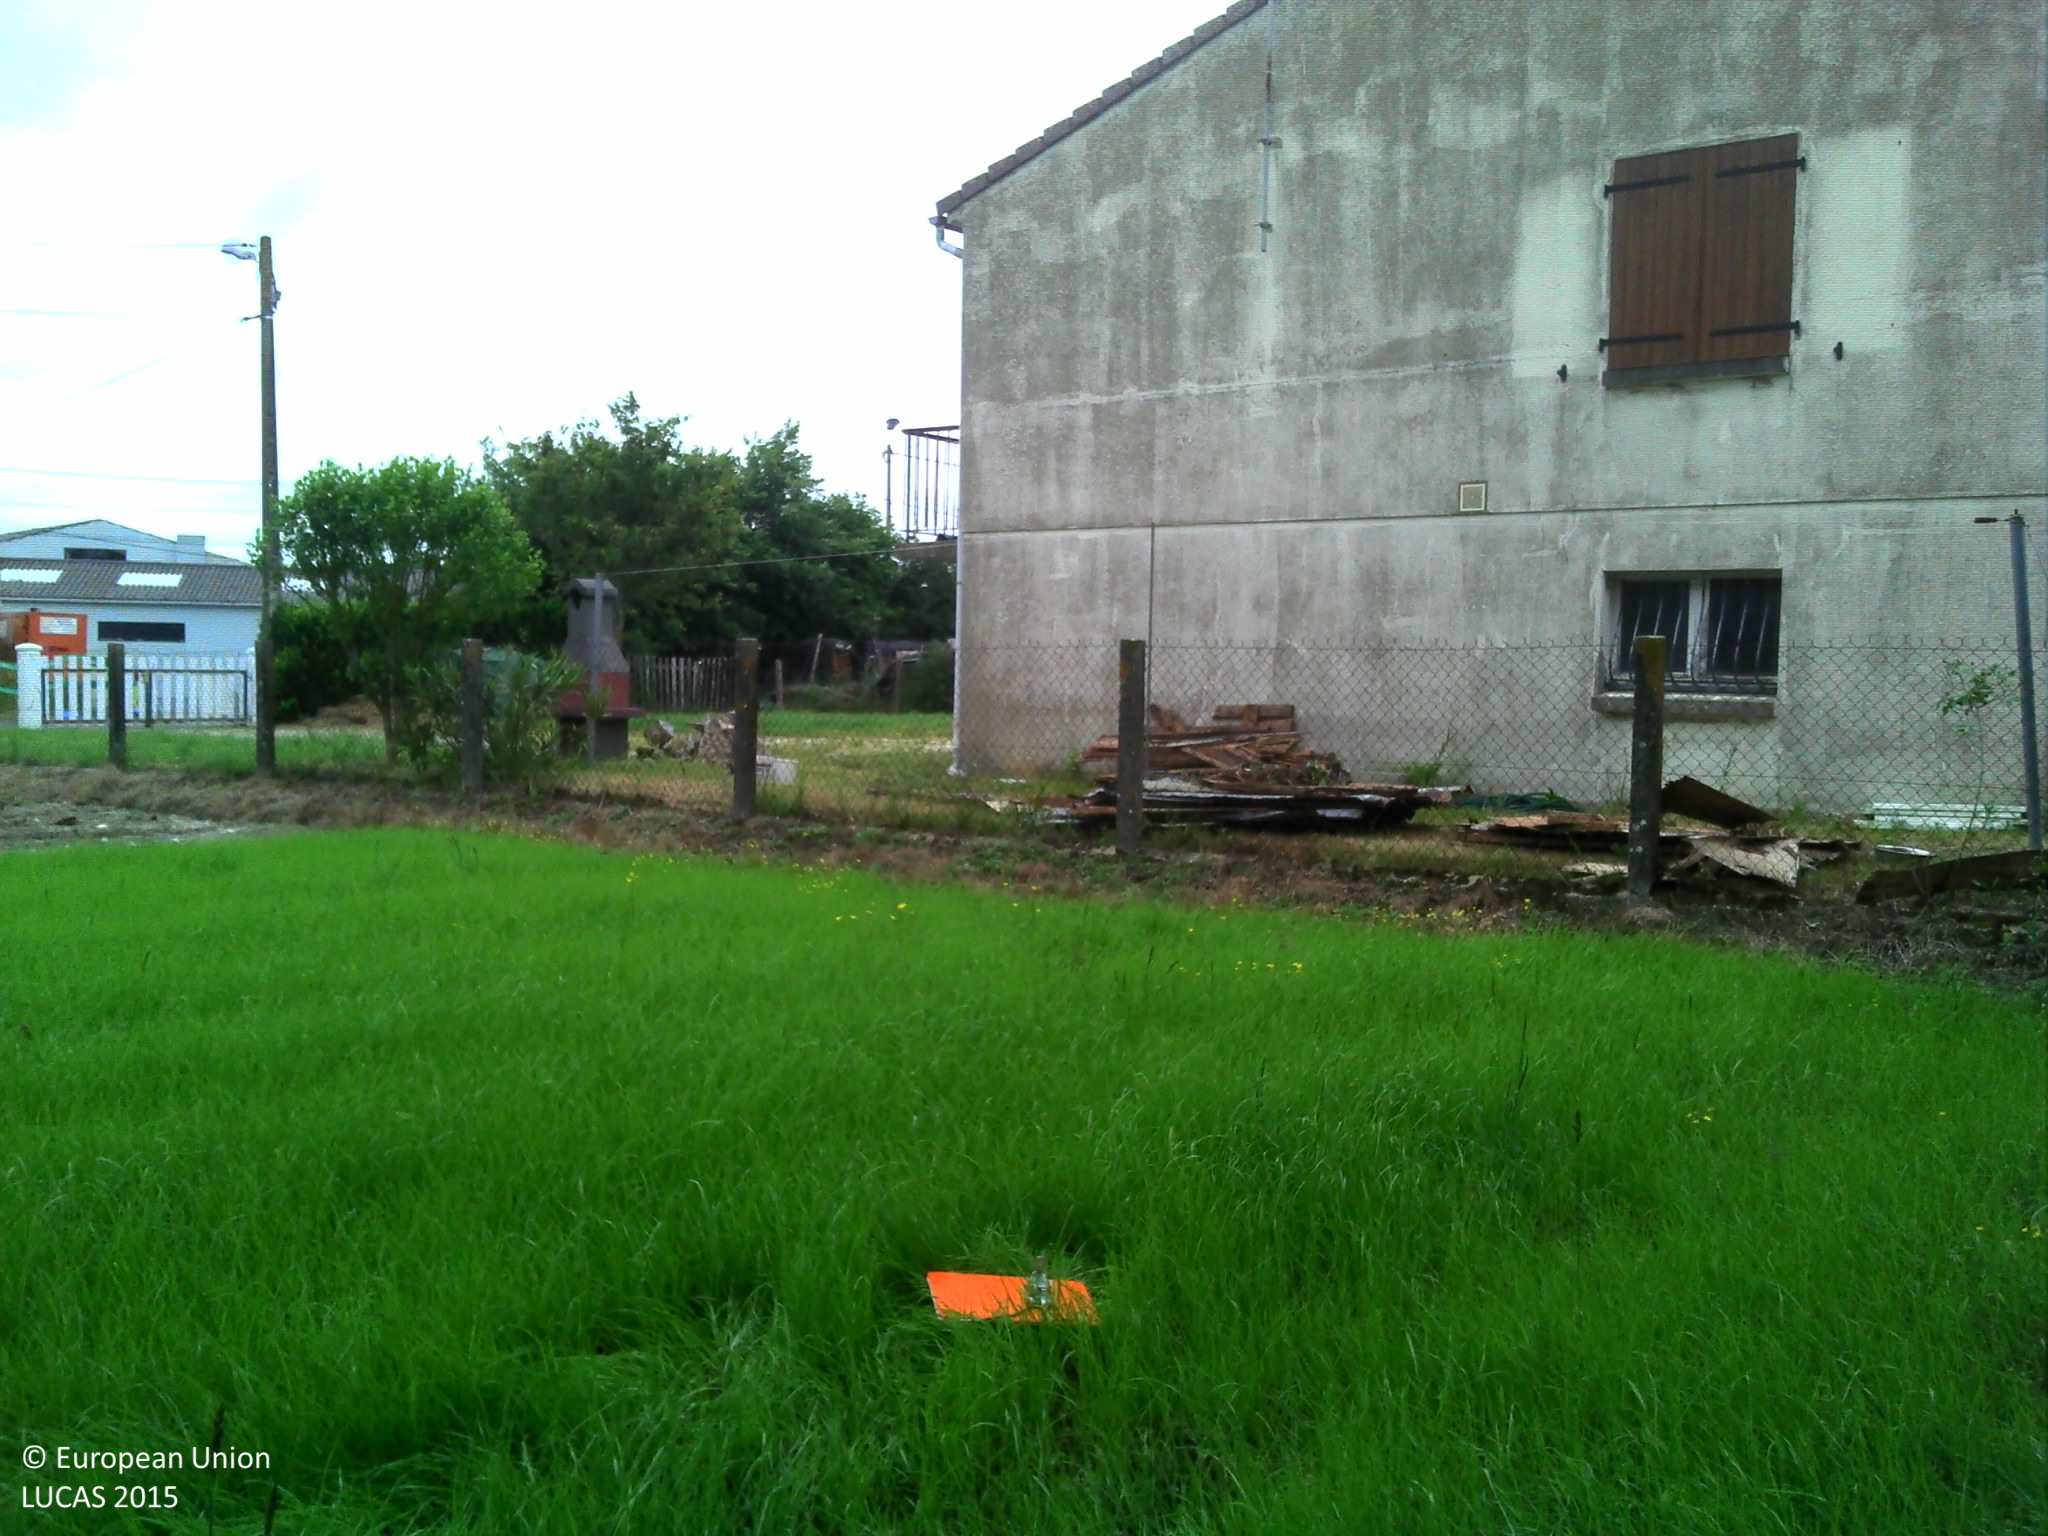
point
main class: Grassland
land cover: Grassland without tree/shrub cover
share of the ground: > 75 %
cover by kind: herbaceous plants 100 %
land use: Residential
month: June
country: FR
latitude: 46.8588
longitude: -1.8093
